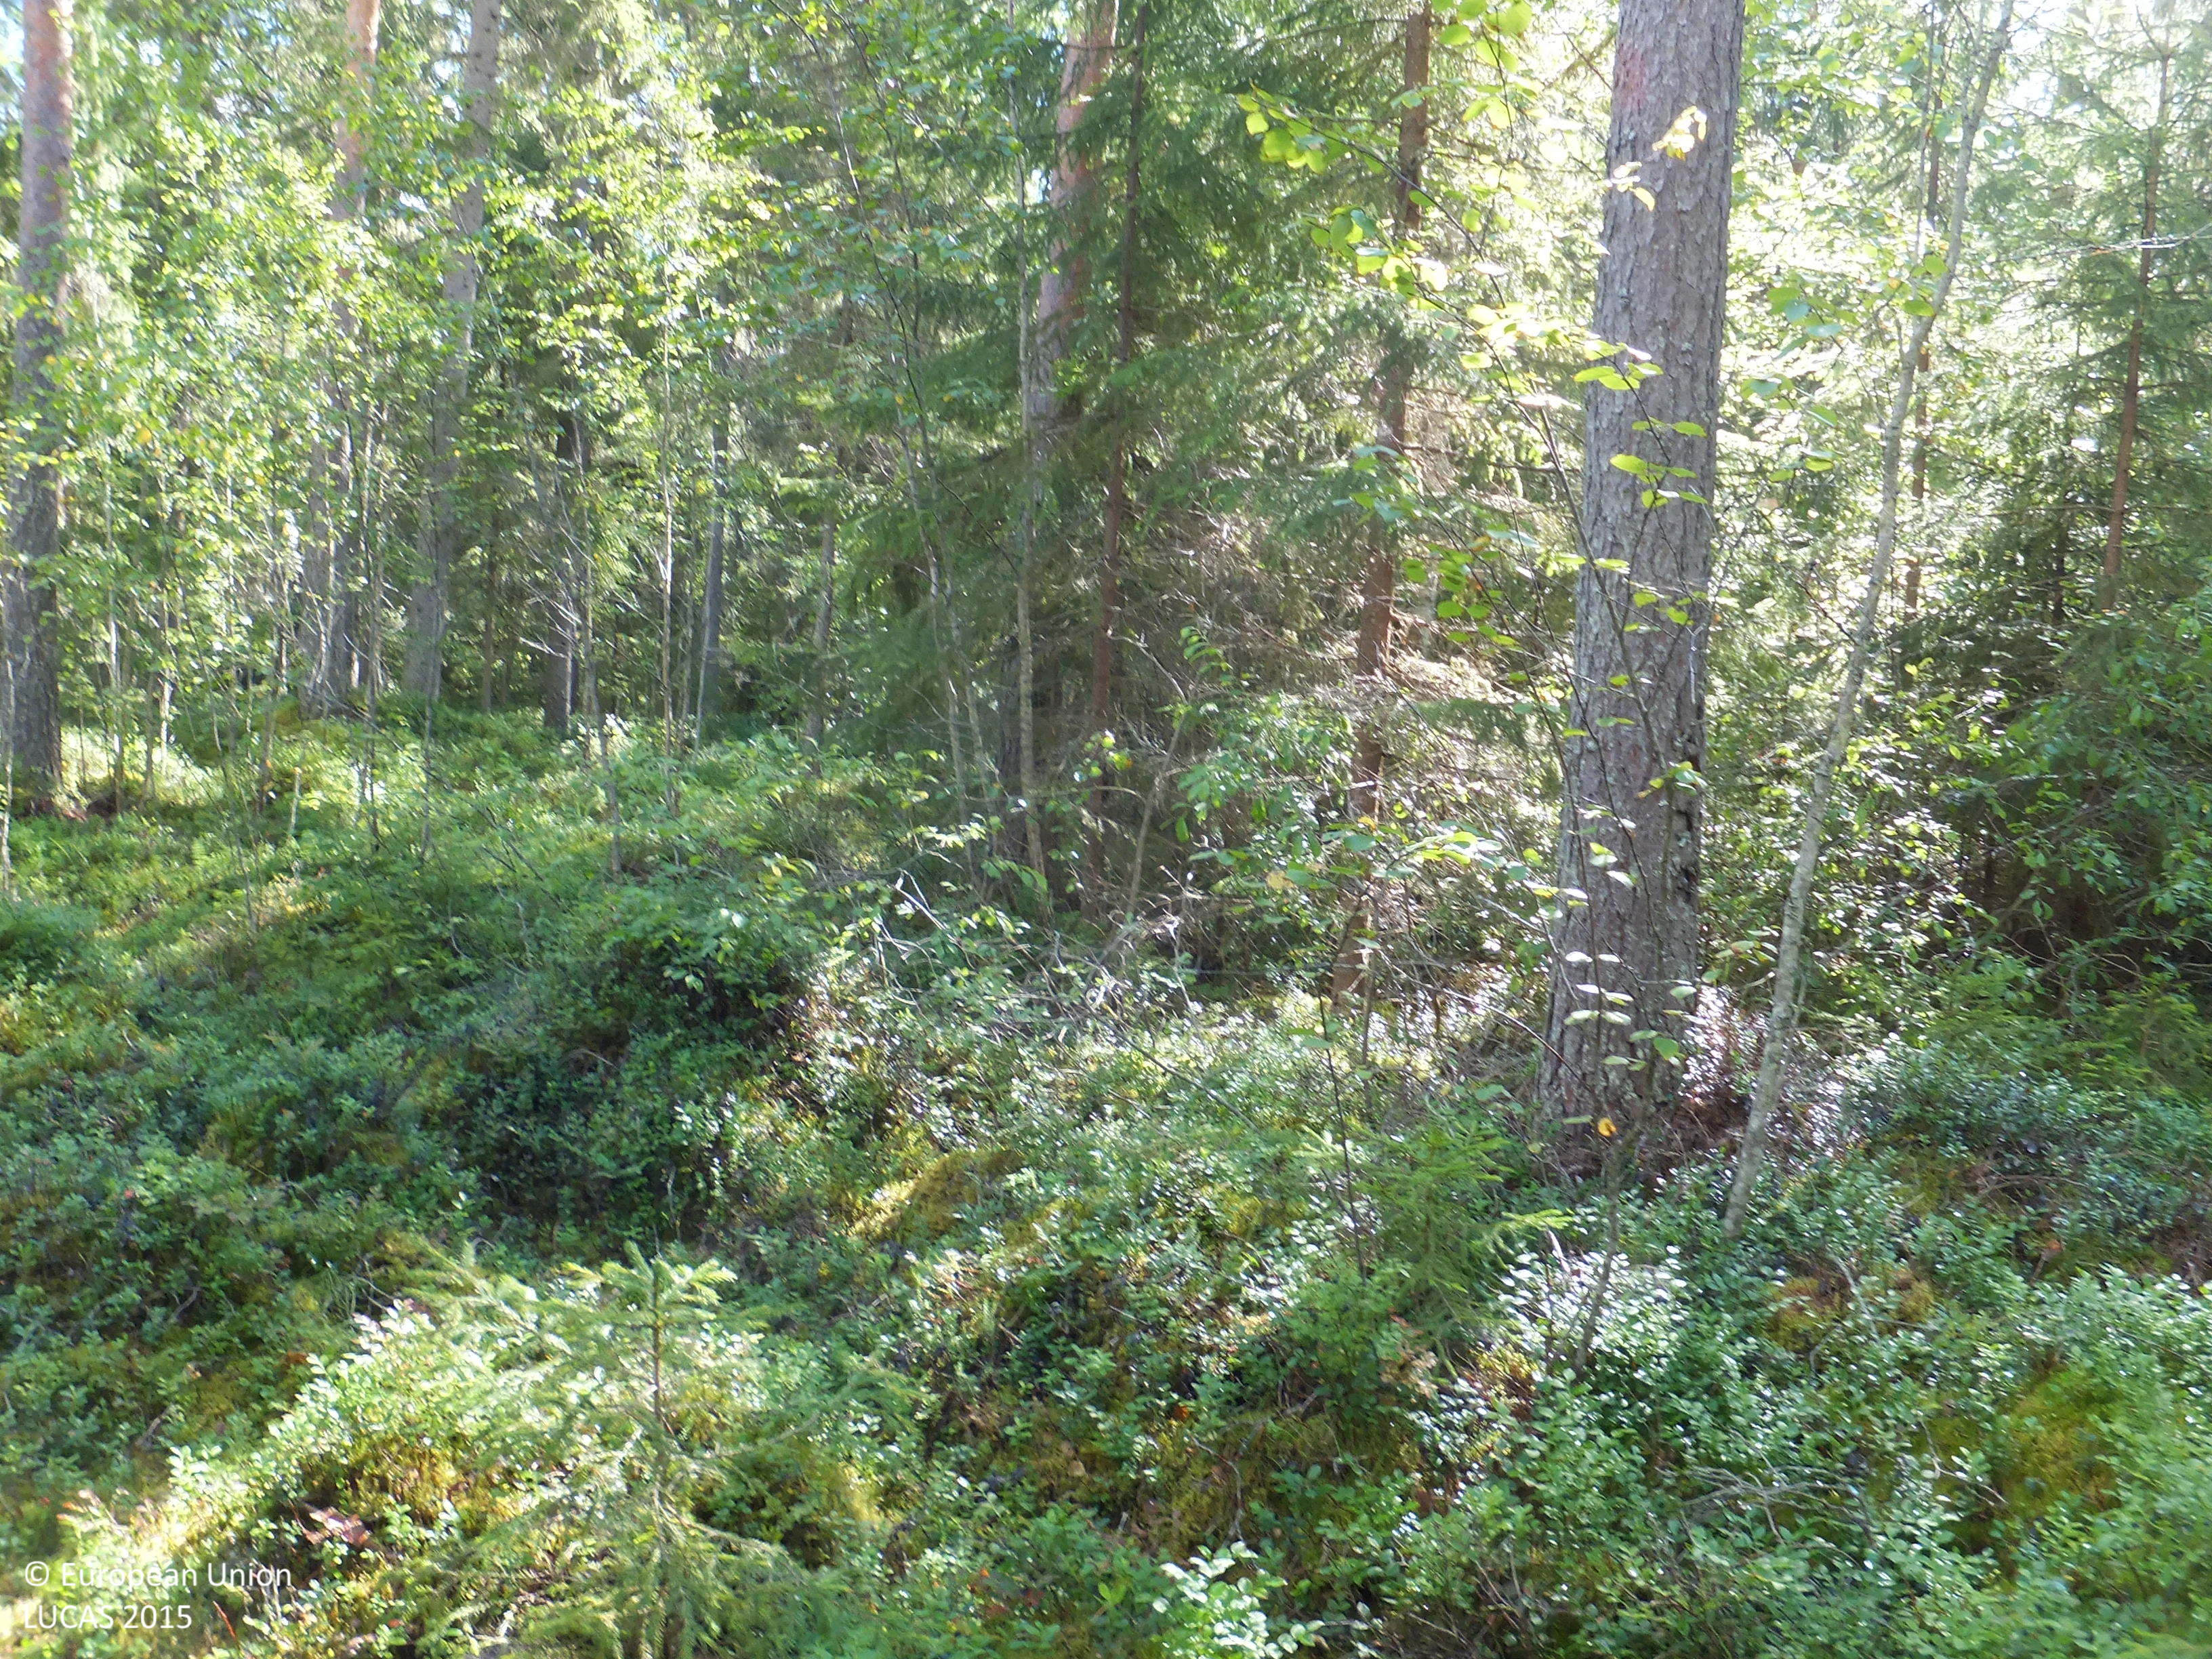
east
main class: Woodland
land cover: Other mixed woodland
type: boreal forest
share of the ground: 50 - 75 %
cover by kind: coniferous forest trees 40 %, broadleaved forest trees 20 %, shrubs 20 %, lichens and mosses 15 %, herbaceous plants 5 %
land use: Forestry
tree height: > 5 m
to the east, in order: Other mixed woodland; Spruce dominated mixed woodland; Ditches and canals; Spruce dominated mixed woodland; Pine dominated mixed woodland; Other mixed woodland; Pine dominated mixed woodland
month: August
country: FI
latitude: 63.0579
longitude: 22.7351
